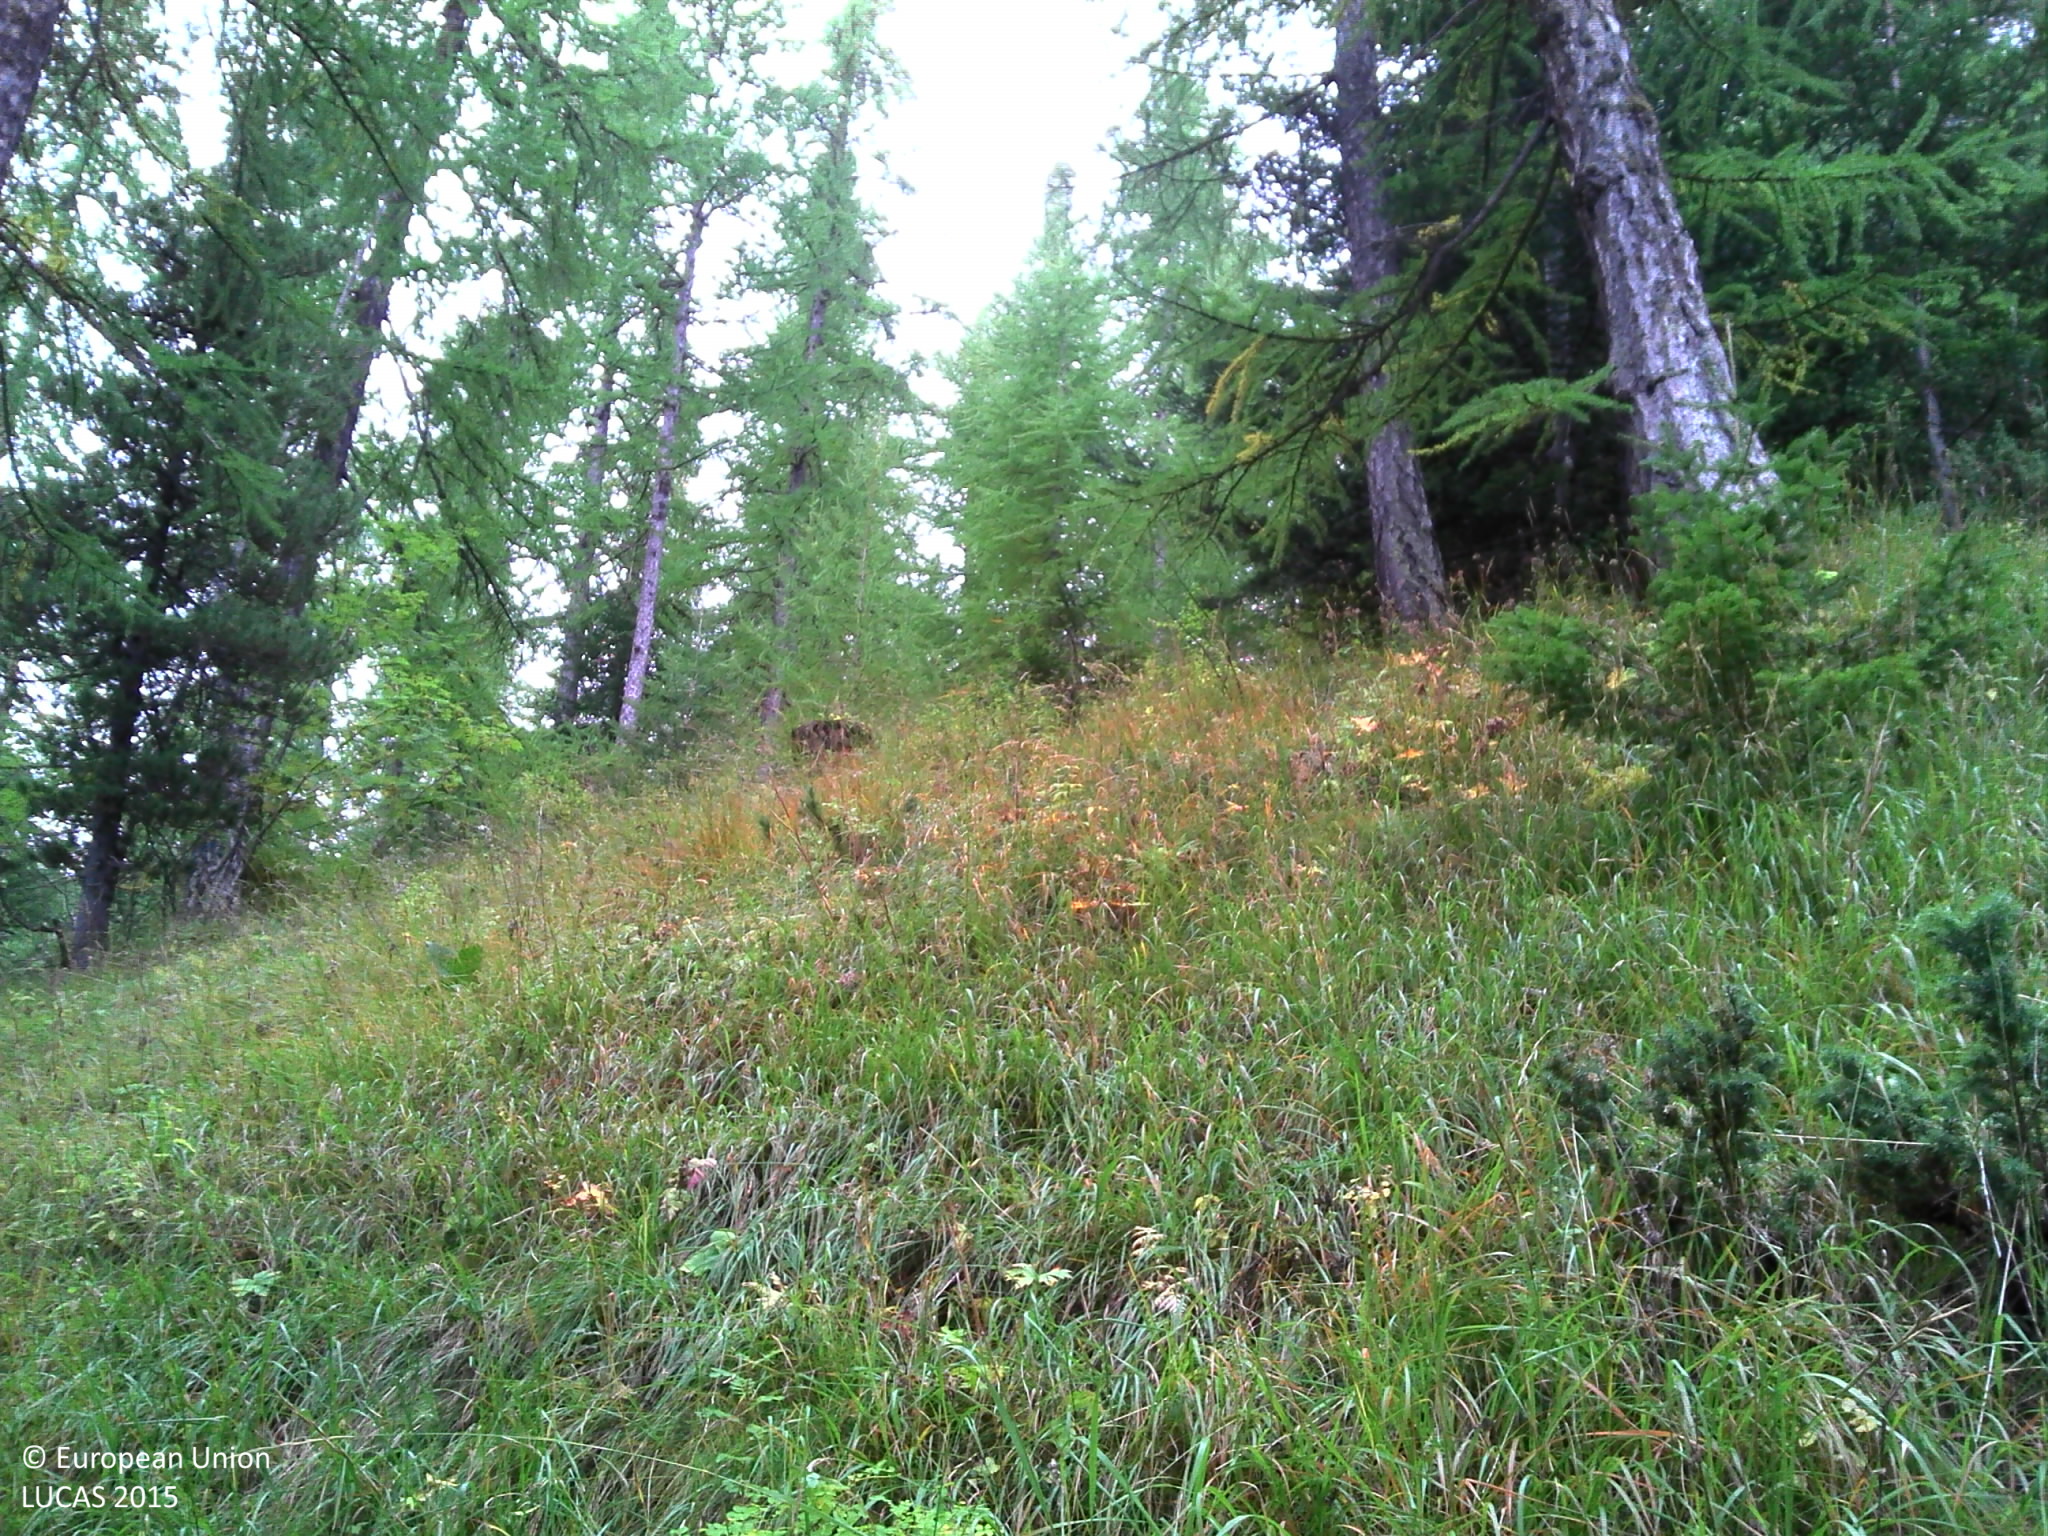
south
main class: Woodland
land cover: Other coniferous woodland
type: alpine coniferous forest
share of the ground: 50 - 75 %
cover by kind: coniferous forest trees 50 %, herbaceous plants 35 %, broadleaved forest trees 10 %, shrubs 5 %
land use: Forestry
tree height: > 5 m
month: September
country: FR
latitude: 44.5466
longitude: 6.5700
